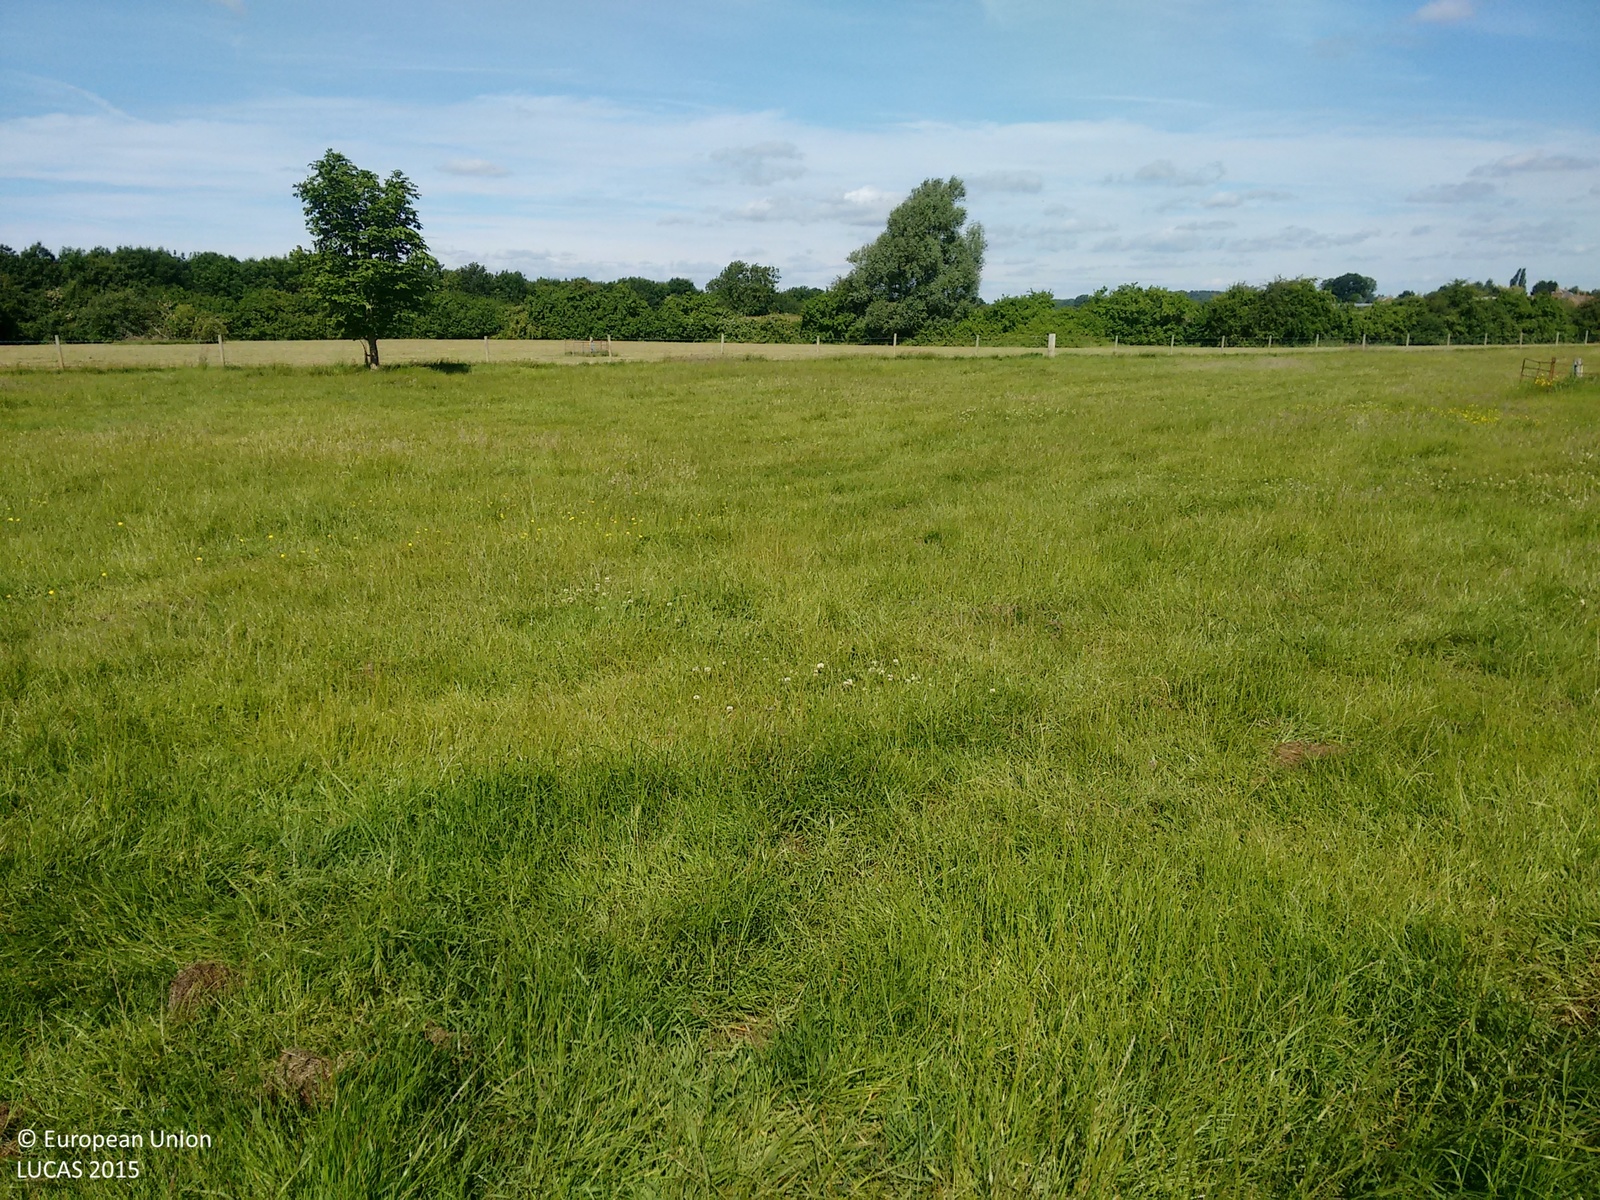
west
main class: Grassland
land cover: Grassland without tree/shrub cover
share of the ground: > 75 %
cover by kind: herbaceous plants 100 %
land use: Sport
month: June
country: GB
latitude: 52.0862
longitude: -2.0703
